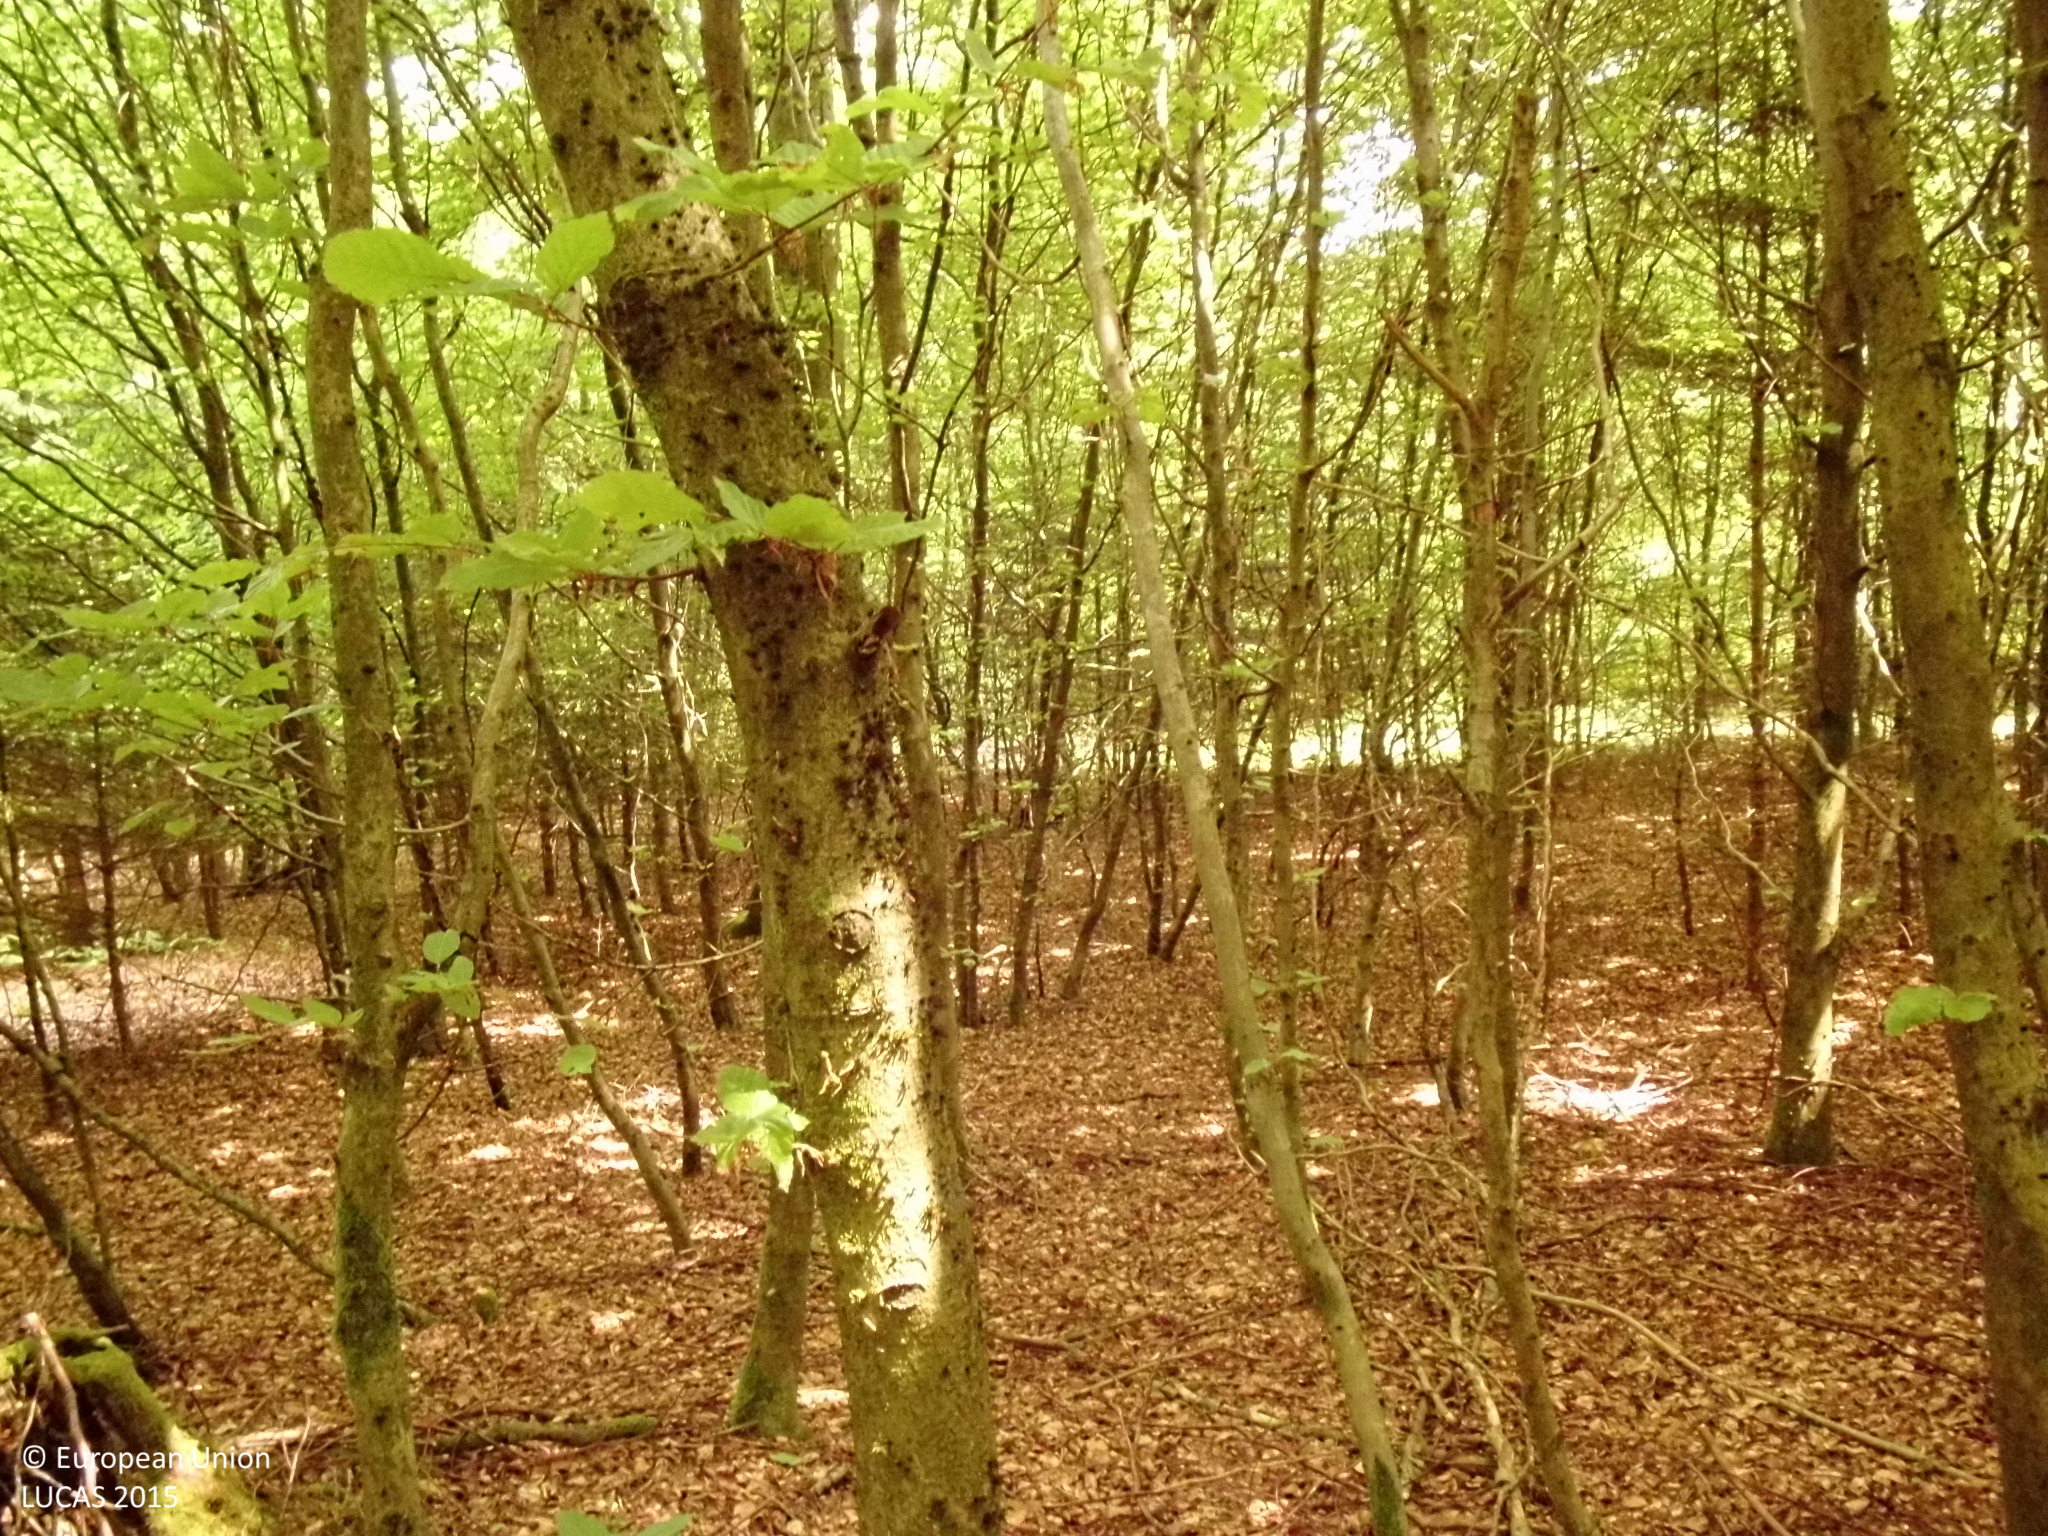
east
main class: Woodland
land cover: Spruce dominated mixed woodland
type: hemiboreal forest and nemoral coniferous forest and mixed broadleaved-coniferous forest
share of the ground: > 75 %
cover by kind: coniferous forest trees 70 %, broadleaved forest trees 30 %
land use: Forestry
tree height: > 5 m
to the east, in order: Spruce dominated mixed woodland; Broadleaved woodland; Tracks; Broadleaved woodland; Other bare soil; Broadleaved woodland
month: May
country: DE
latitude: 50.5539
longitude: 7.5585
